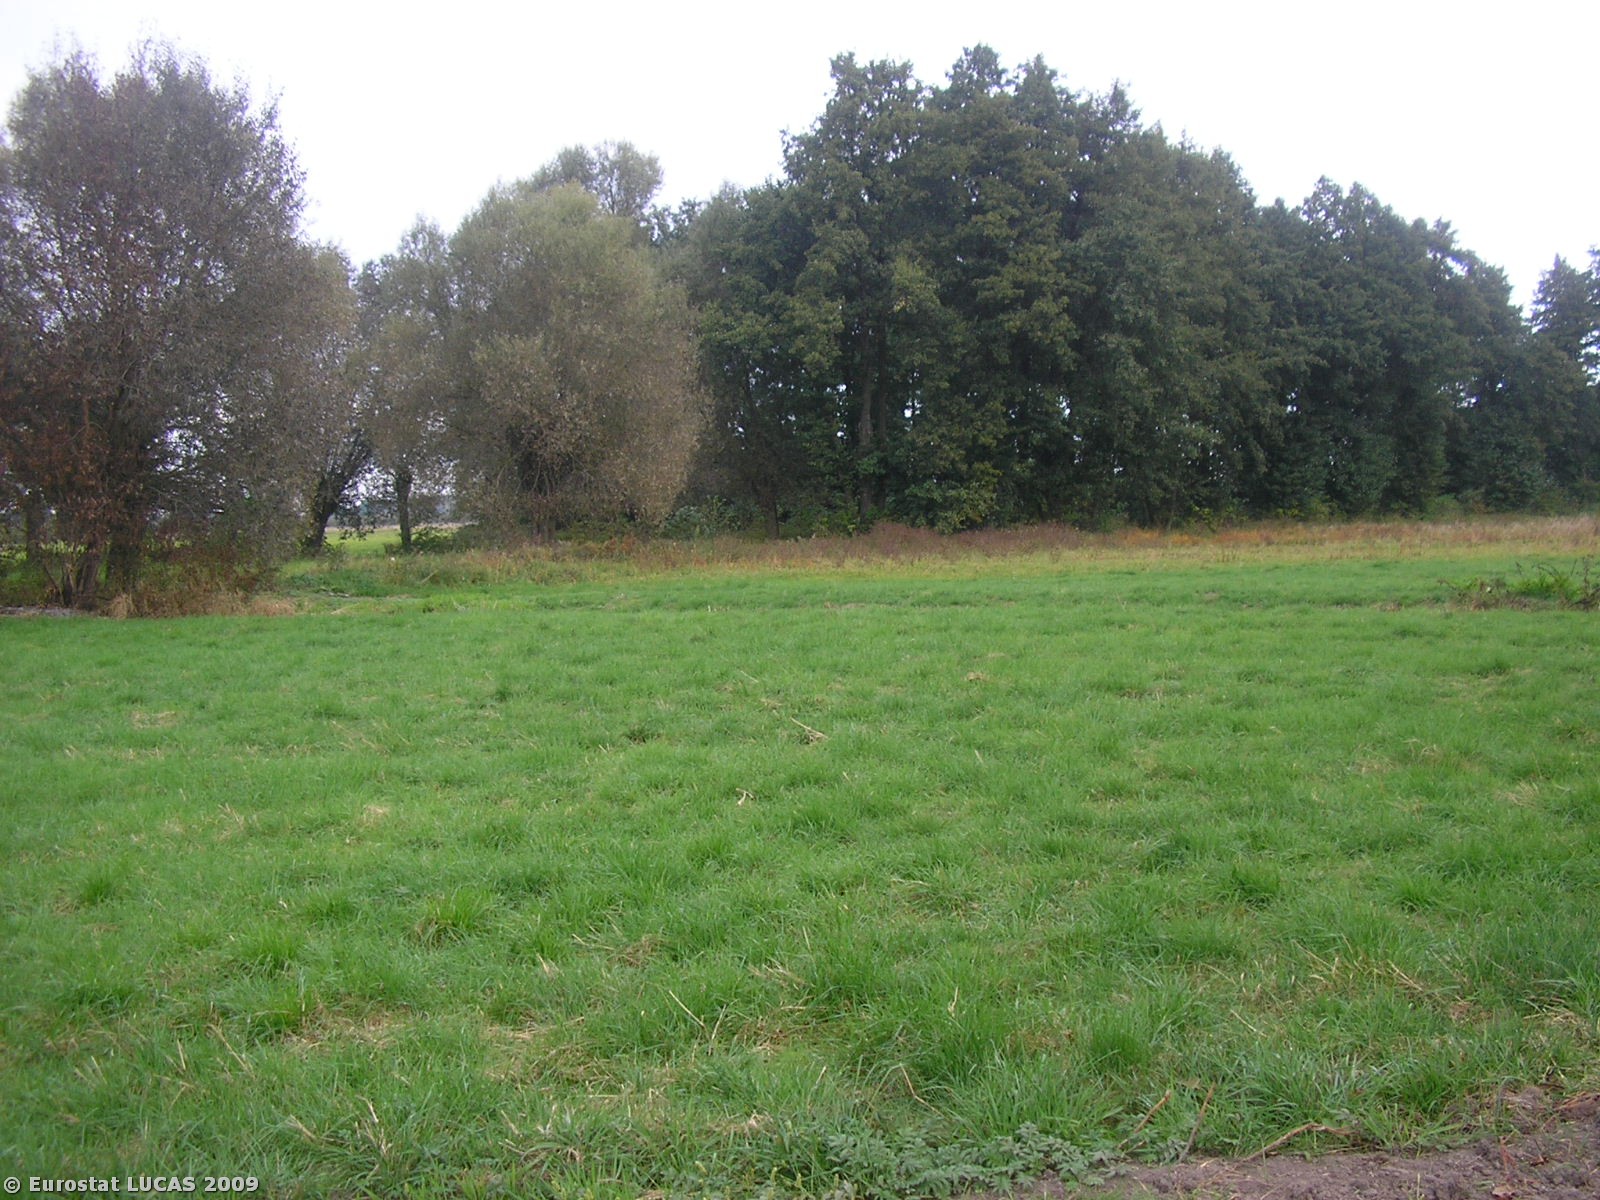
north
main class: Cropland
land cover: Triticale
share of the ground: < 10 %
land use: Agriculture (excluding fallow land and kitchen gardens)
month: September
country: PL
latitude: 51.7928
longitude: 20.9910
